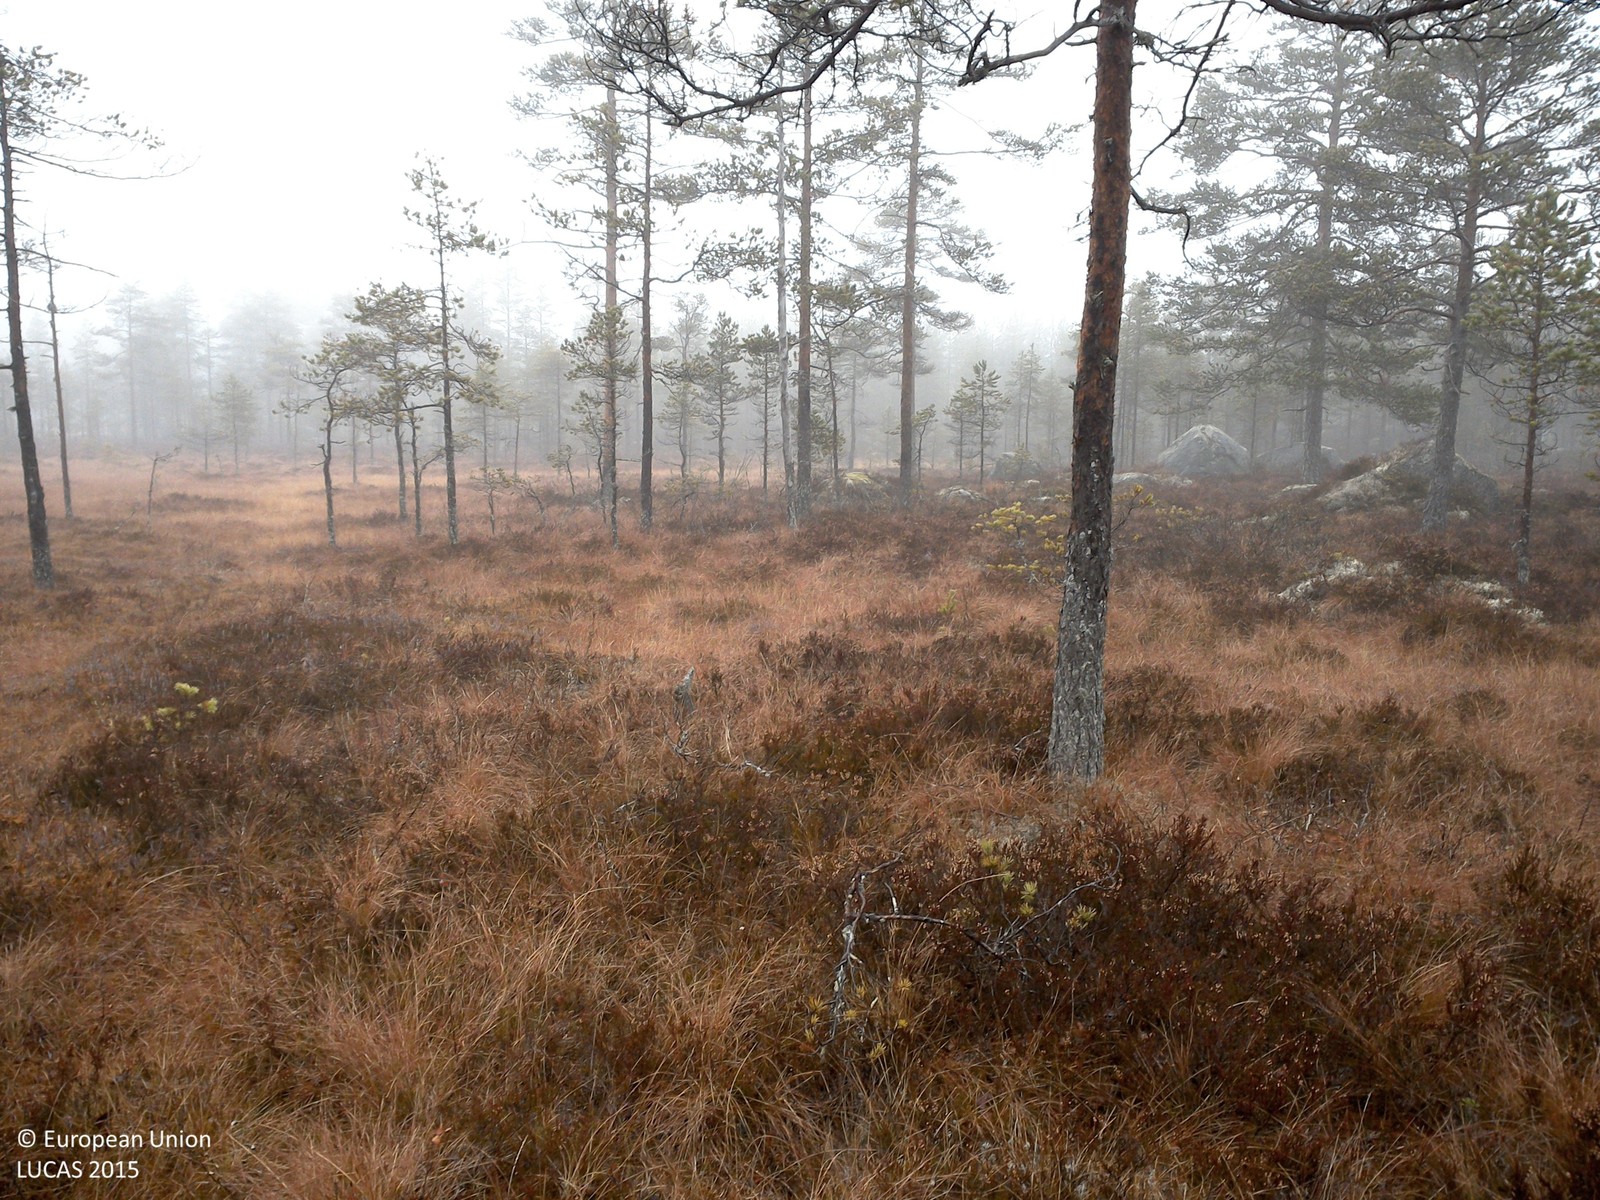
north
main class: Woodland
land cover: Pine dominated coniferous woodland
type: boreal forest
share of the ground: 25 - 50 %
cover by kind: coniferous forest trees 40 %, shrubs 30 %, herbaceous plants 15 %, lichens and mosses 15 %
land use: Forestry
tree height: > 5 m
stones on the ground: < 10 %
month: November
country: SE
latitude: 60.5901
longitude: 14.6796
